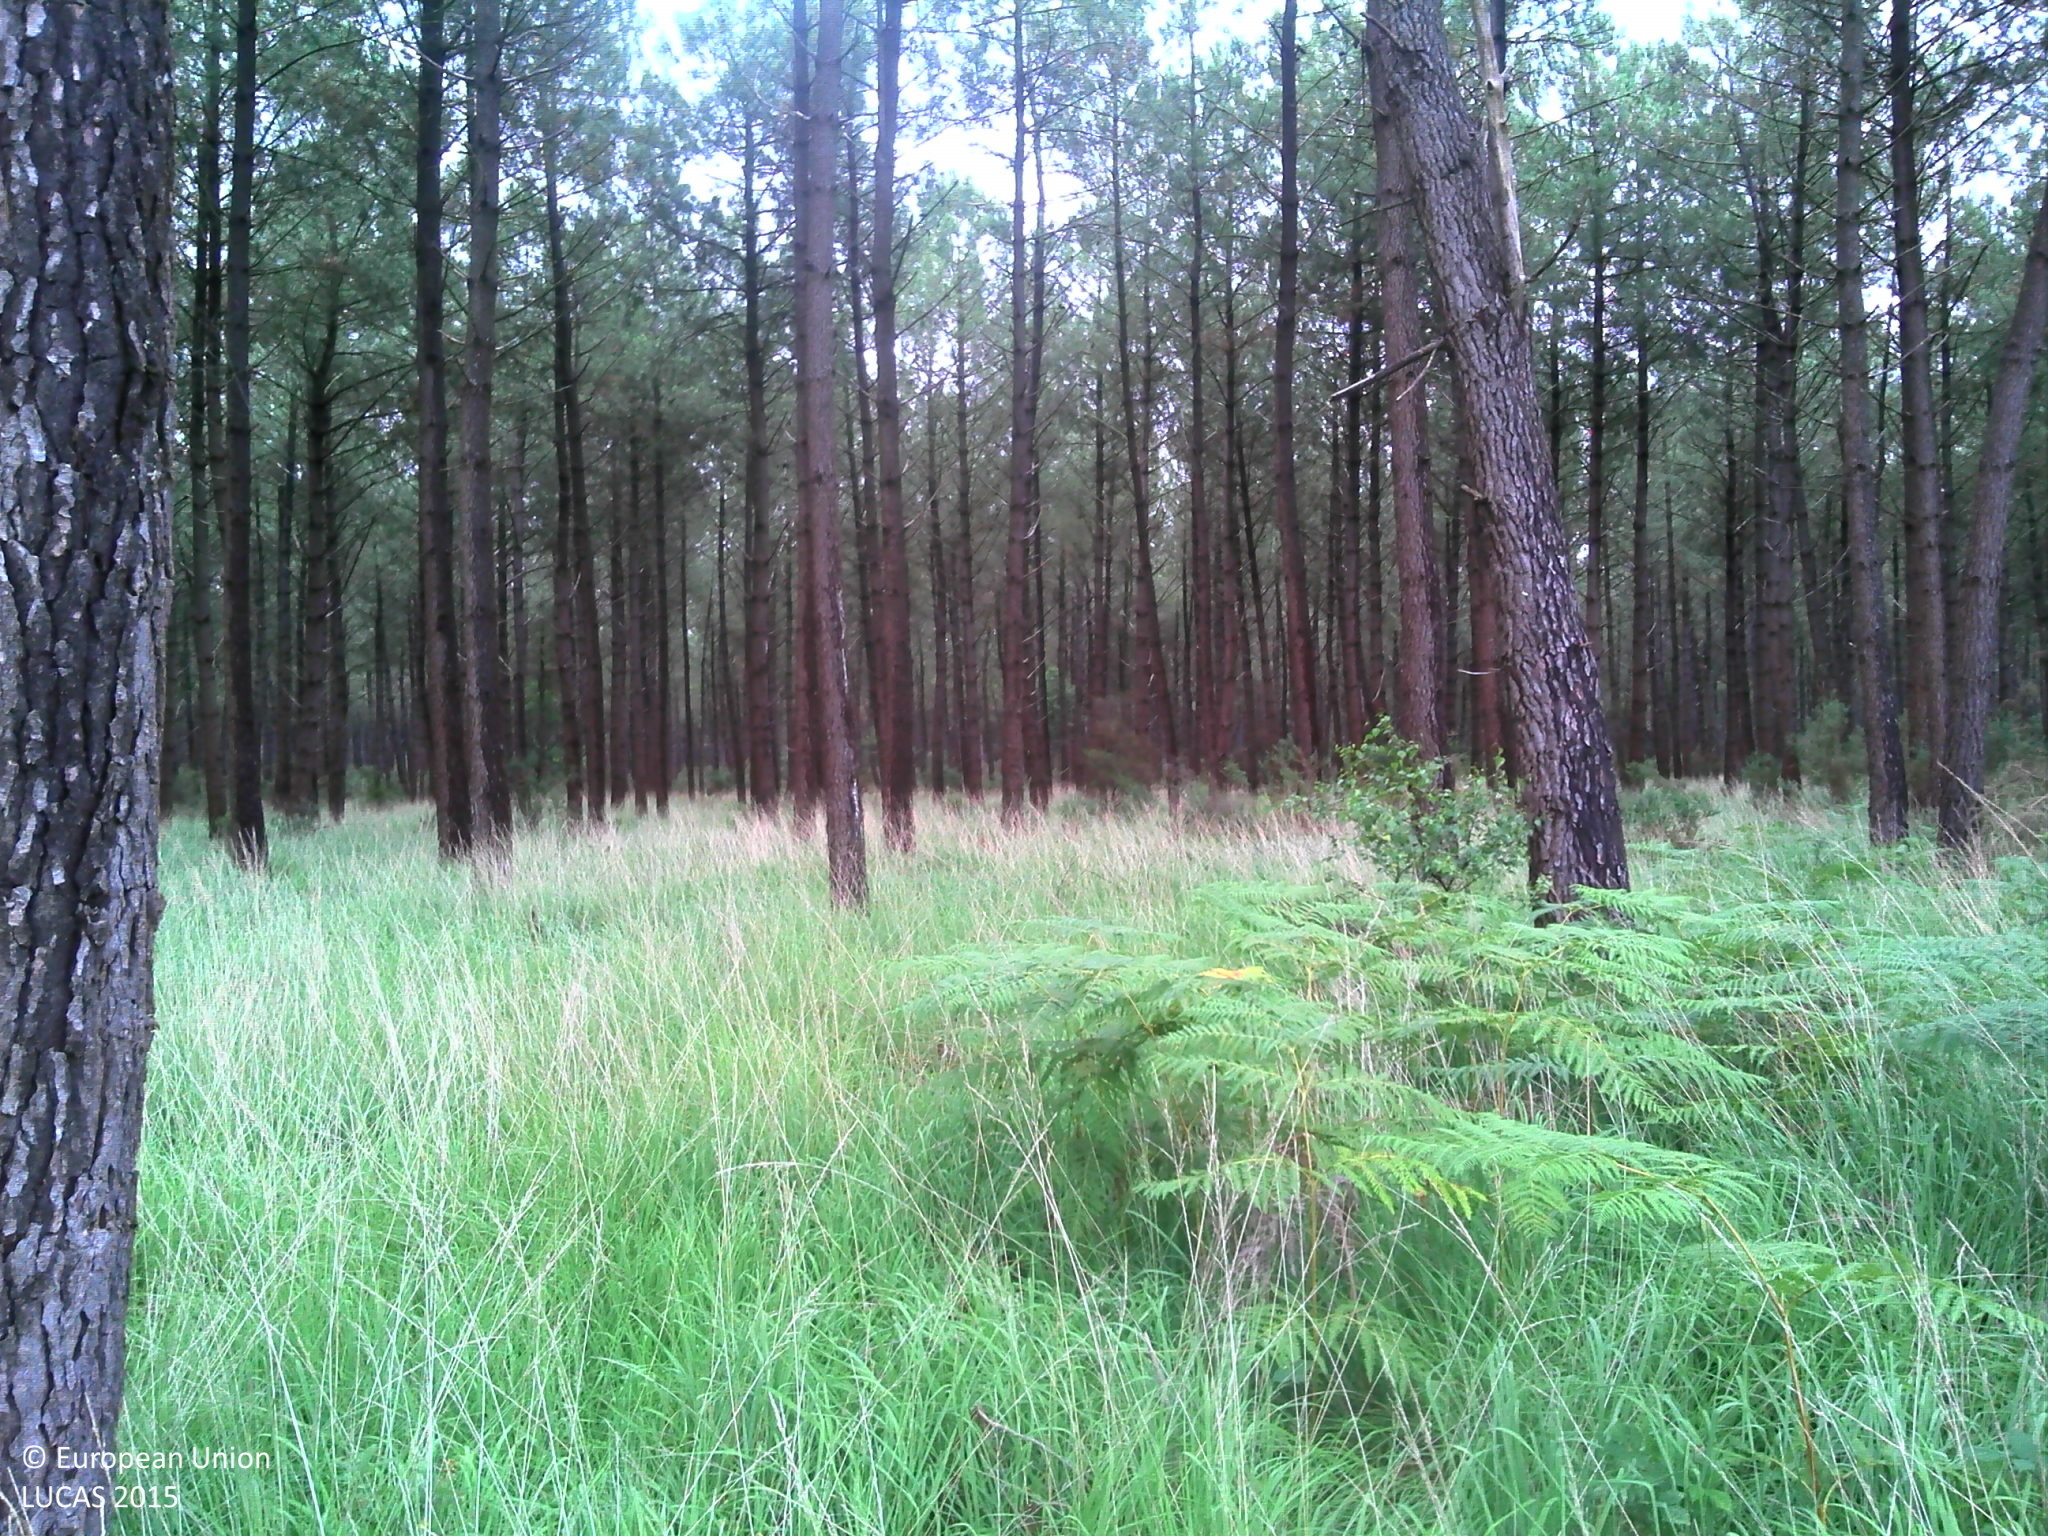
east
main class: Woodland
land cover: Pine dominated coniferous woodland
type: exotic forest
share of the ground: > 75 %
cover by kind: coniferous forest trees 95 %, herbaceous plants 5 %
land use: Forestry
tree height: > 5 m
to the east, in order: Pine dominated coniferous woodland; Shrubland without tree cover; Pine dominated coniferous woodland; Tracks; Pine dominated coniferous woodland
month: July
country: FR
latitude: 47.5089
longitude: -1.8512
